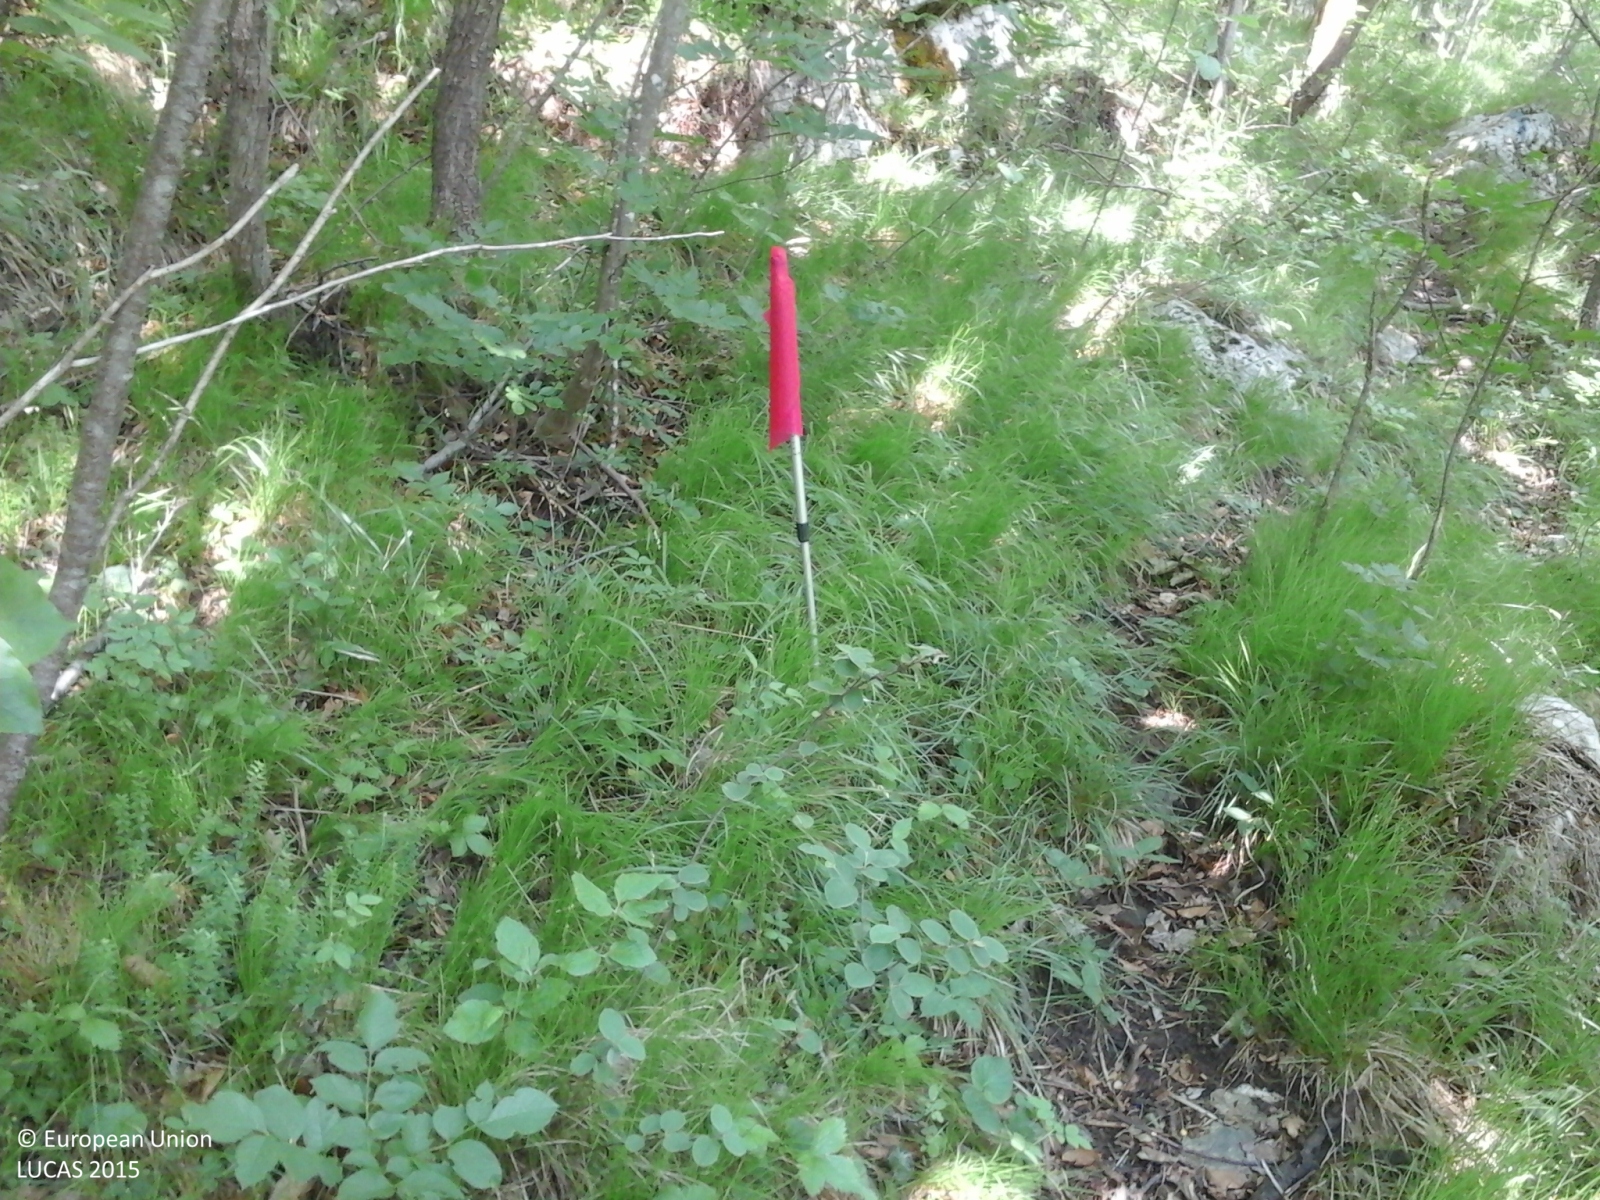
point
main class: Woodland
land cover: Broadleaved woodland
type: thermophilous deciduous forest
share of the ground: > 75 %
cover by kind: broadleaved forest trees 100 %
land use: Forestry
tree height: > 5 m
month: June
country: IT
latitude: 46.0033
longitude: 11.0960
